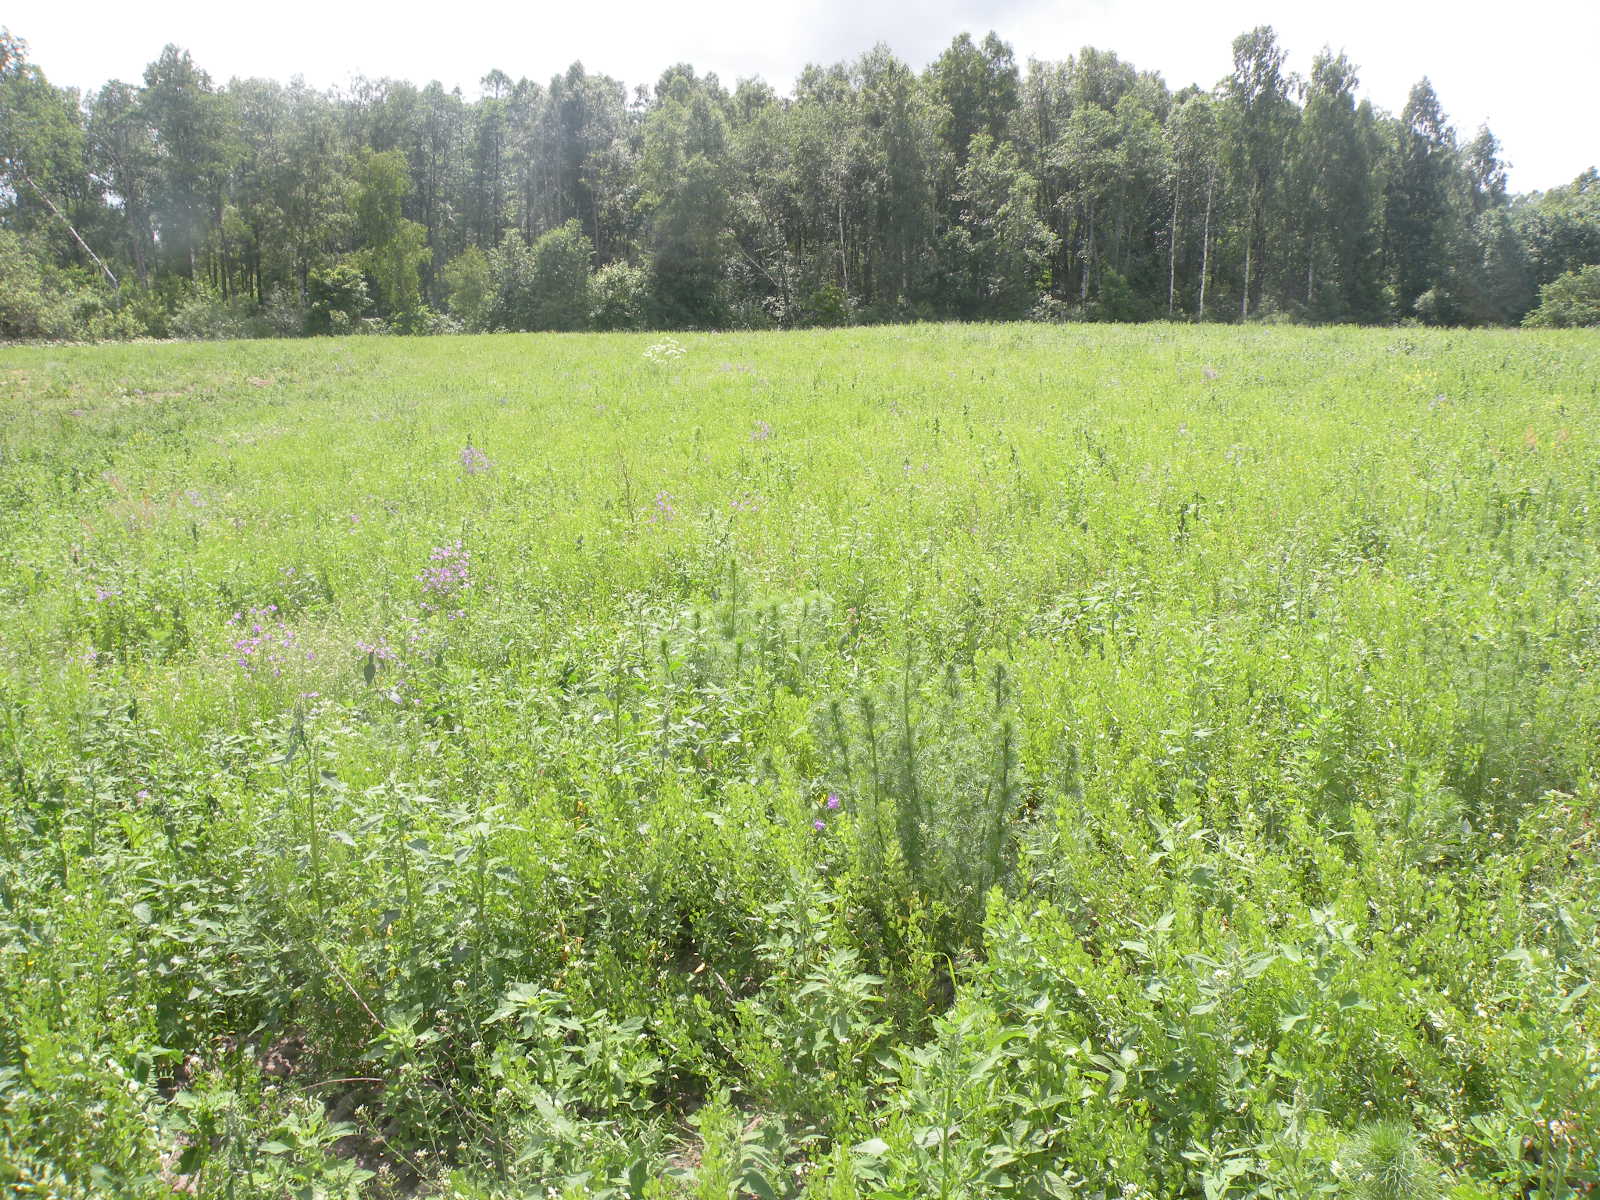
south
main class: Grassland
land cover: Spontaneously vegetated surfaces
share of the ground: > 75 %
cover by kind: herbaceous plants 95 %, shrubs 5 %
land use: Fallow land
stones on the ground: < 10 %
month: June
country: LV
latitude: 56.0138
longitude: 27.0247
